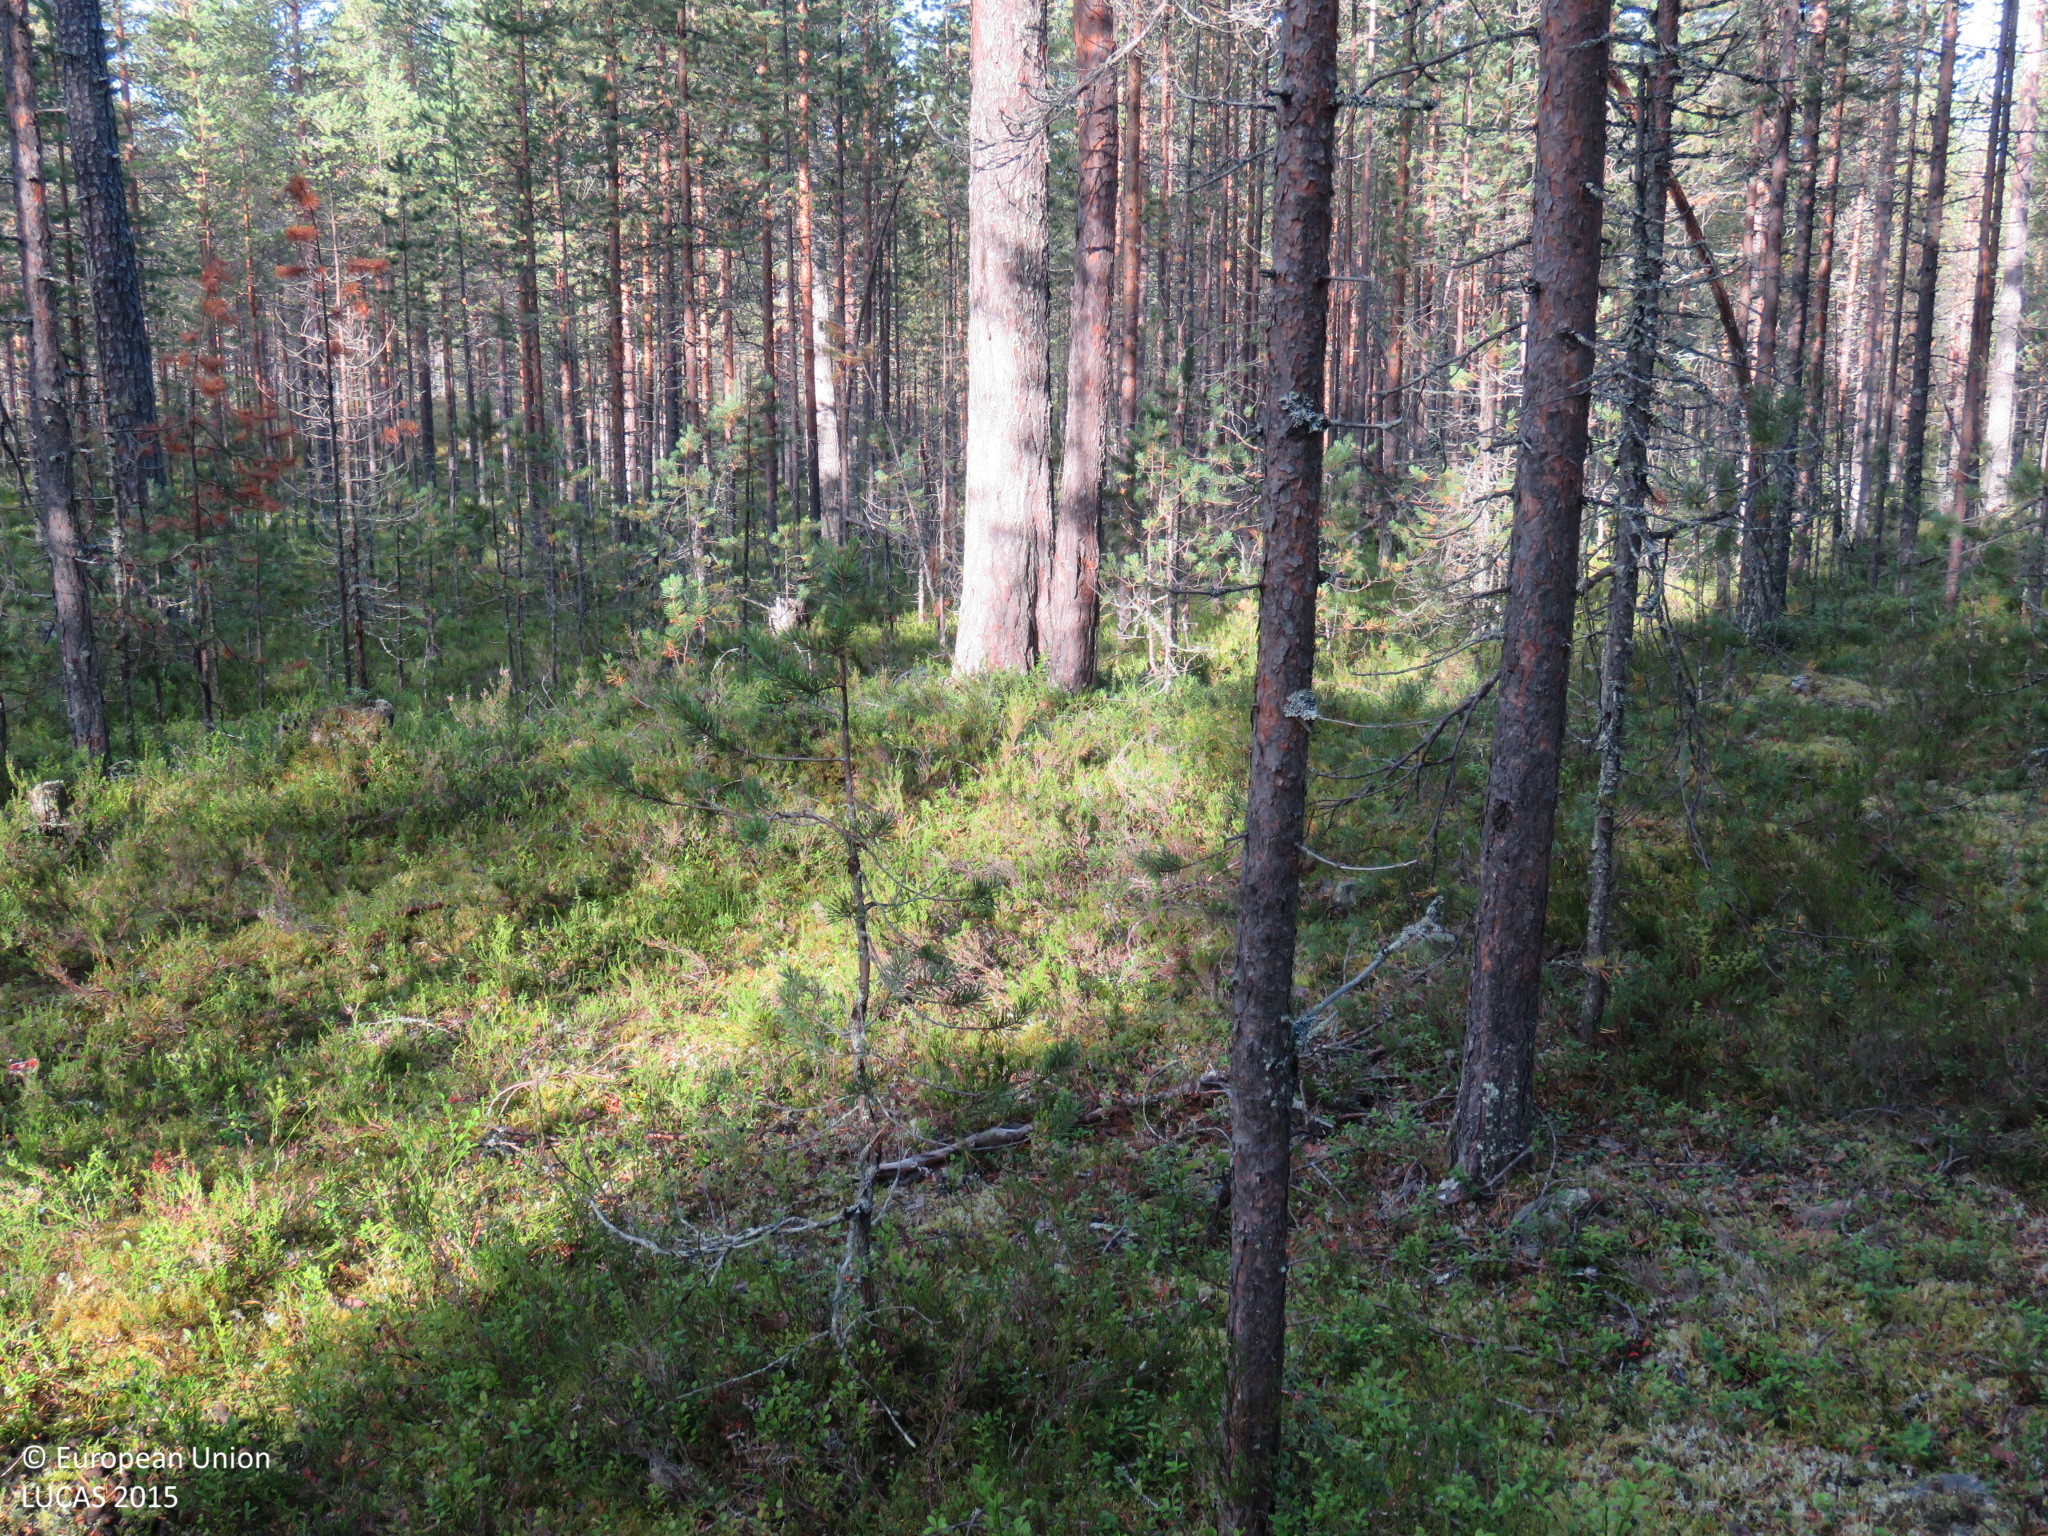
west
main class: Woodland
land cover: Pine dominated coniferous woodland
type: boreal forest
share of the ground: > 75 %
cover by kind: coniferous forest trees 75 %, shrubs 10 %, lichens and mosses 10 %, broadleaved forest trees 5 %
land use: Forestry
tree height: > 5 m
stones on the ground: < 10 %
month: September
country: FI
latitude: 65.3573
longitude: 27.4320
